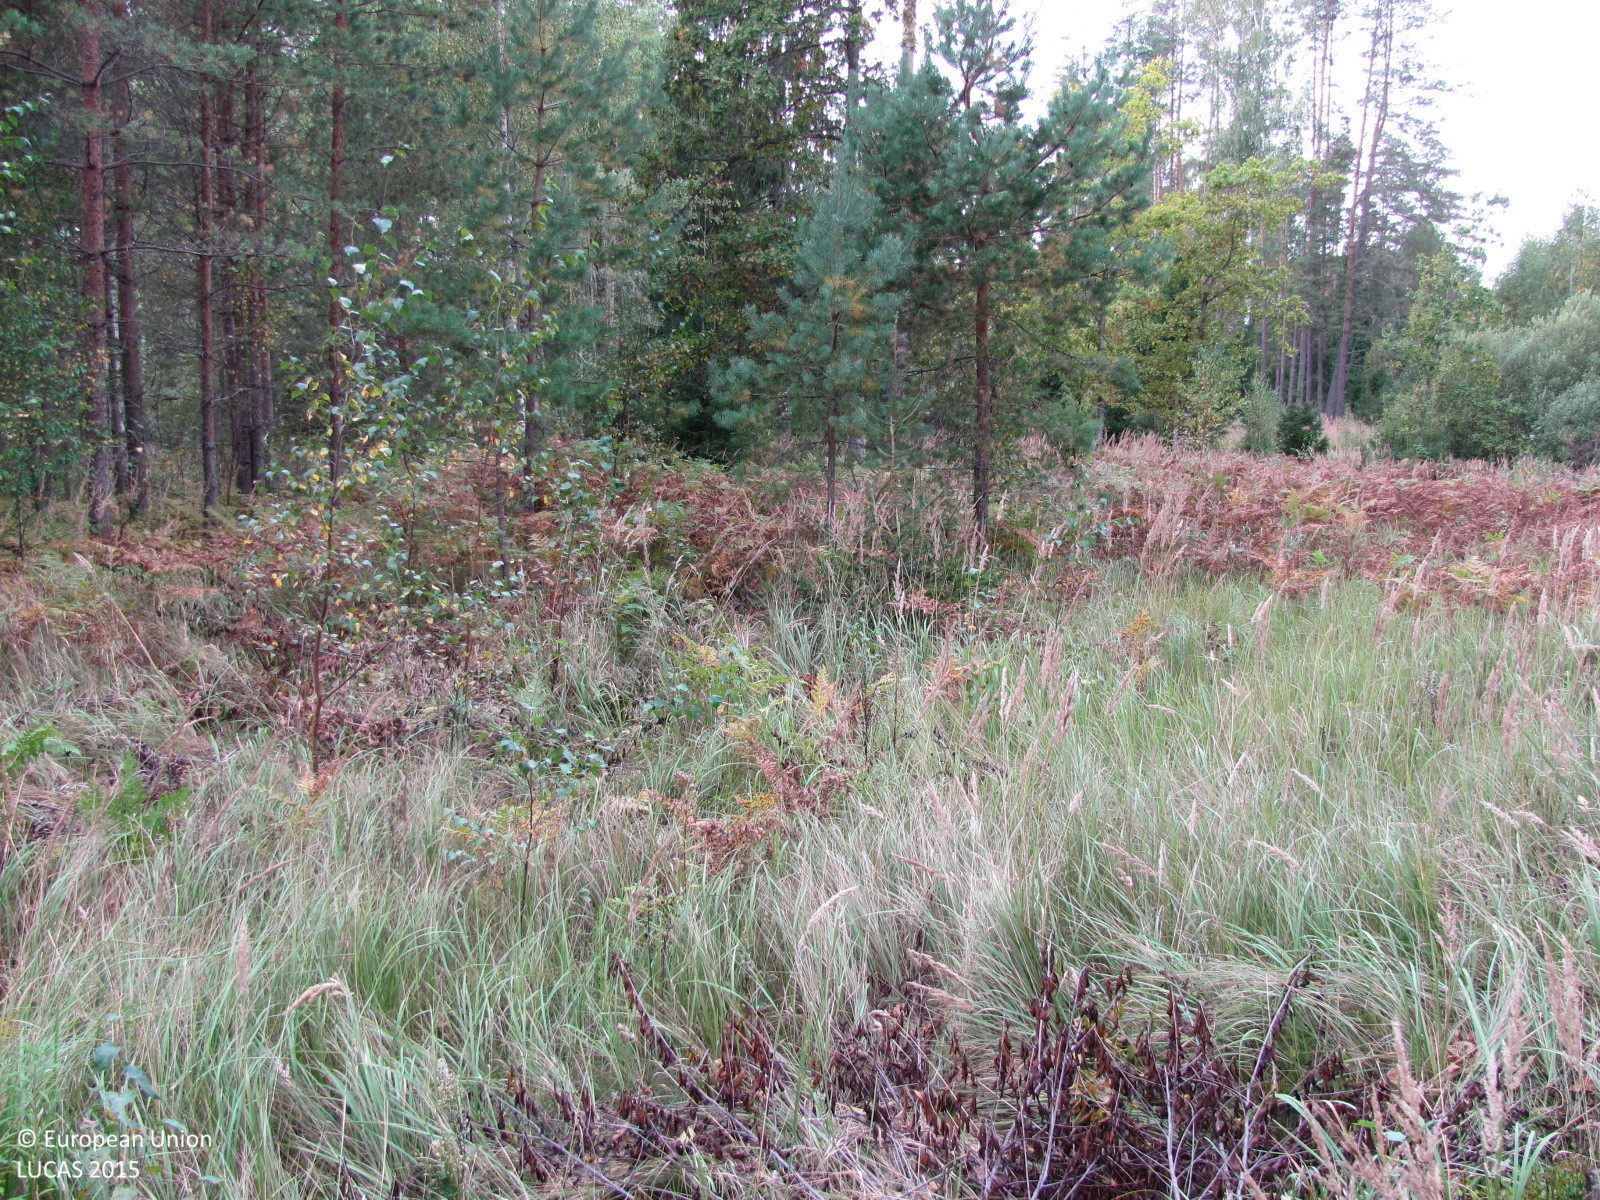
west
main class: Grassland
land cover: Grassland with sparse tree/shrub cover
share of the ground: > 75 %
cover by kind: herbaceous plants 95 %, broadleaved forest trees 5 %
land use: Semi-natural and natural areas not in use
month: September
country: LV
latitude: 57.1351
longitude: 24.6529
